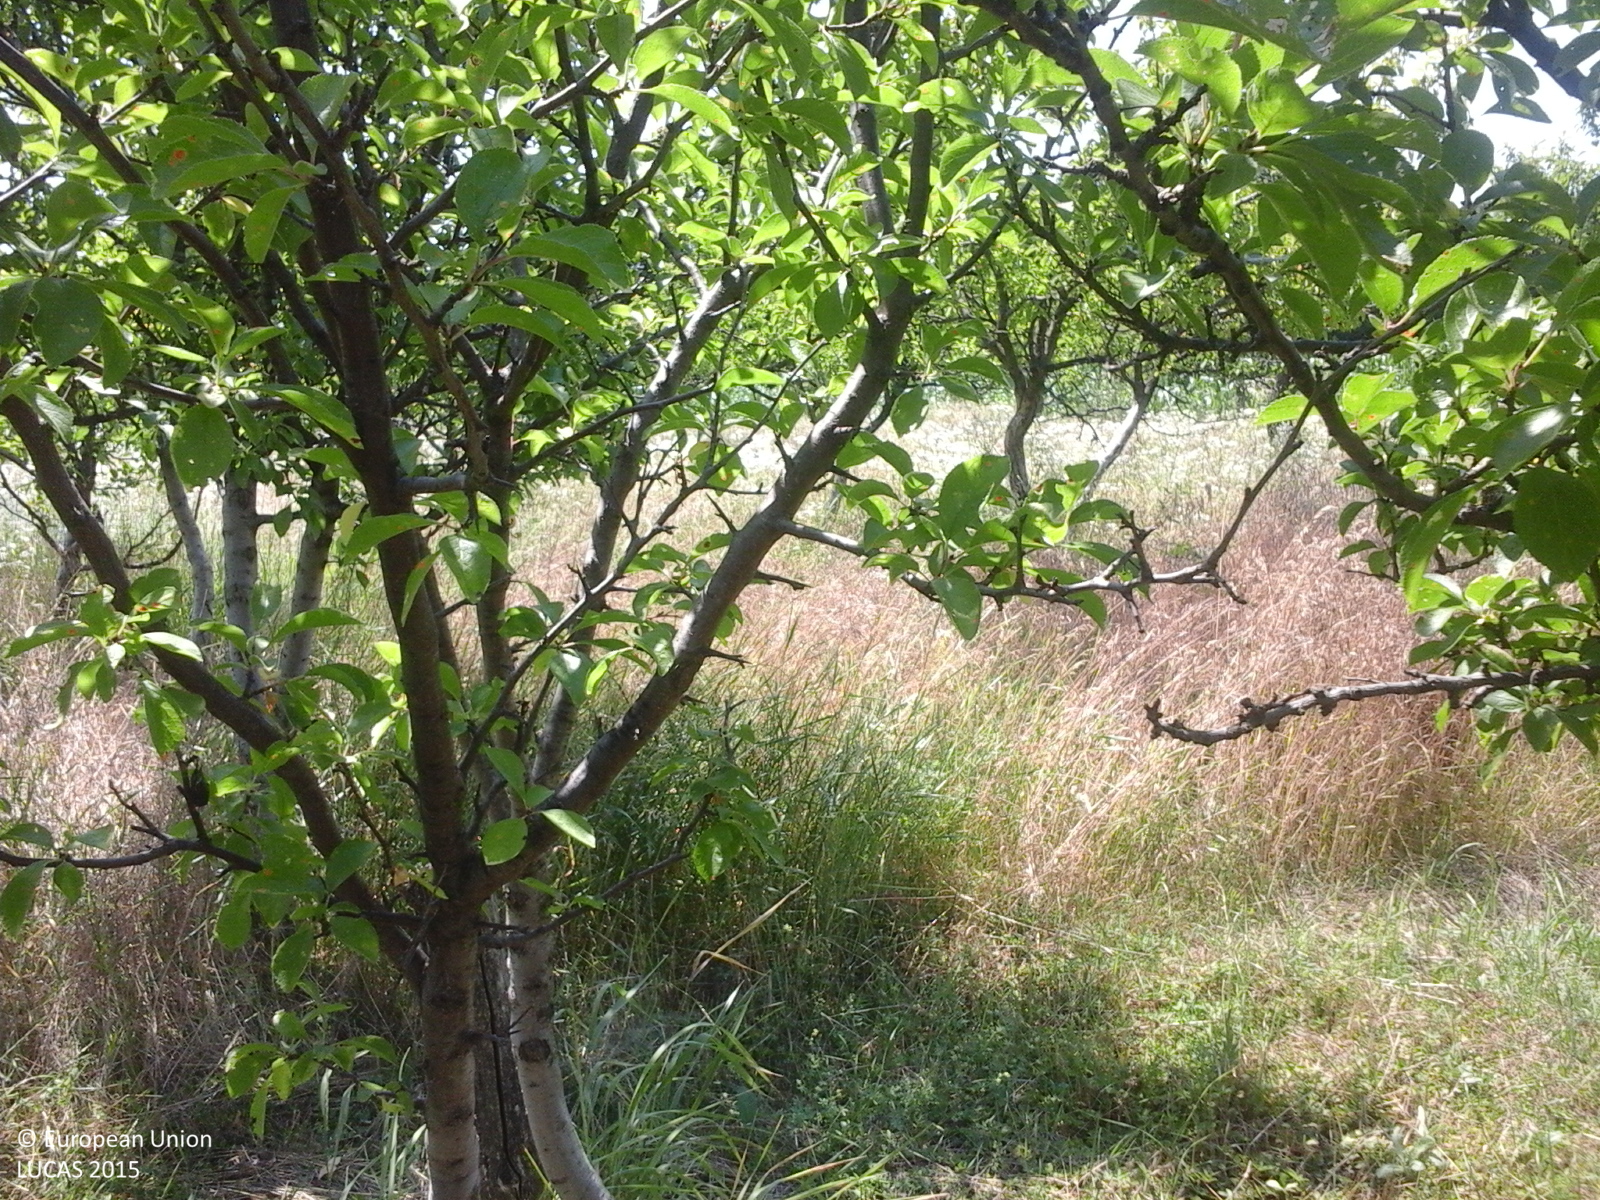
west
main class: Cropland
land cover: Other fruit trees and berries
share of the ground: > 75 %
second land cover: Grassland without tree/shrub cover
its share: > 75 %
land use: Agriculture (excluding fallow land and kitchen gardens)
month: July
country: RO
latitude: 44.8081
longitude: 24.6292
